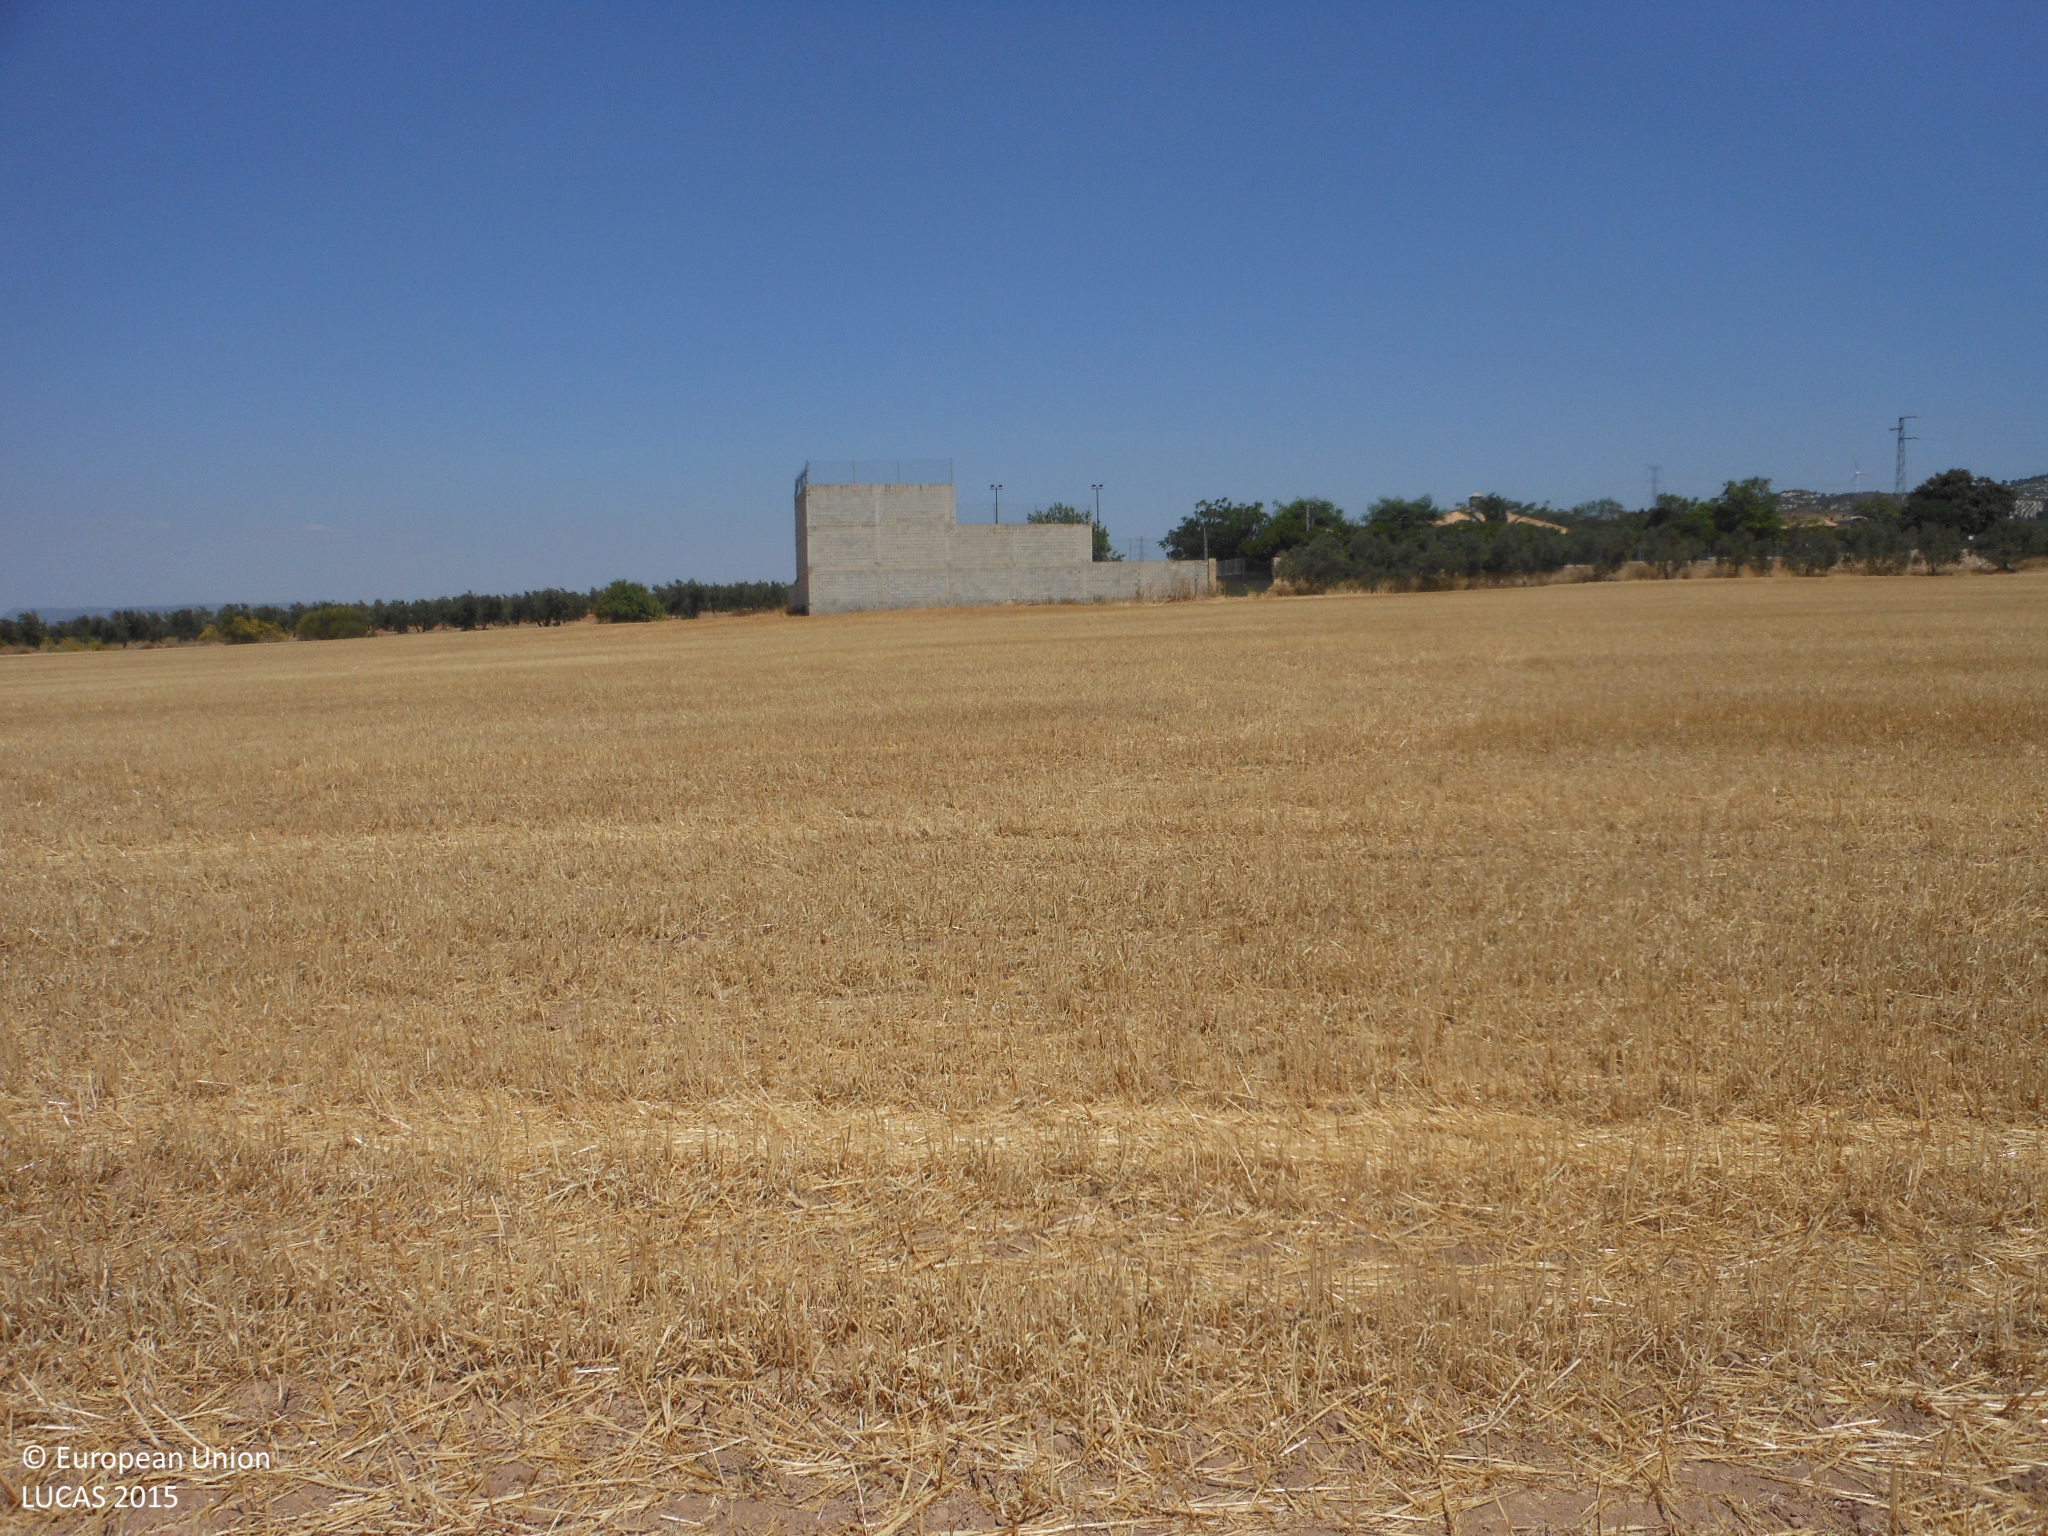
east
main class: Cropland
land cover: Barley
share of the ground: < 10 %
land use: Agriculture (excluding fallow land and kitchen gardens)
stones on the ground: < 10 %
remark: Harvested field
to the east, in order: Barley; Artificial constructions in urban areas; Grass margins; Rivers and streams; Grass margins; Olive groves
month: June
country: ES
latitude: 37.1947
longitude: -5.1143
